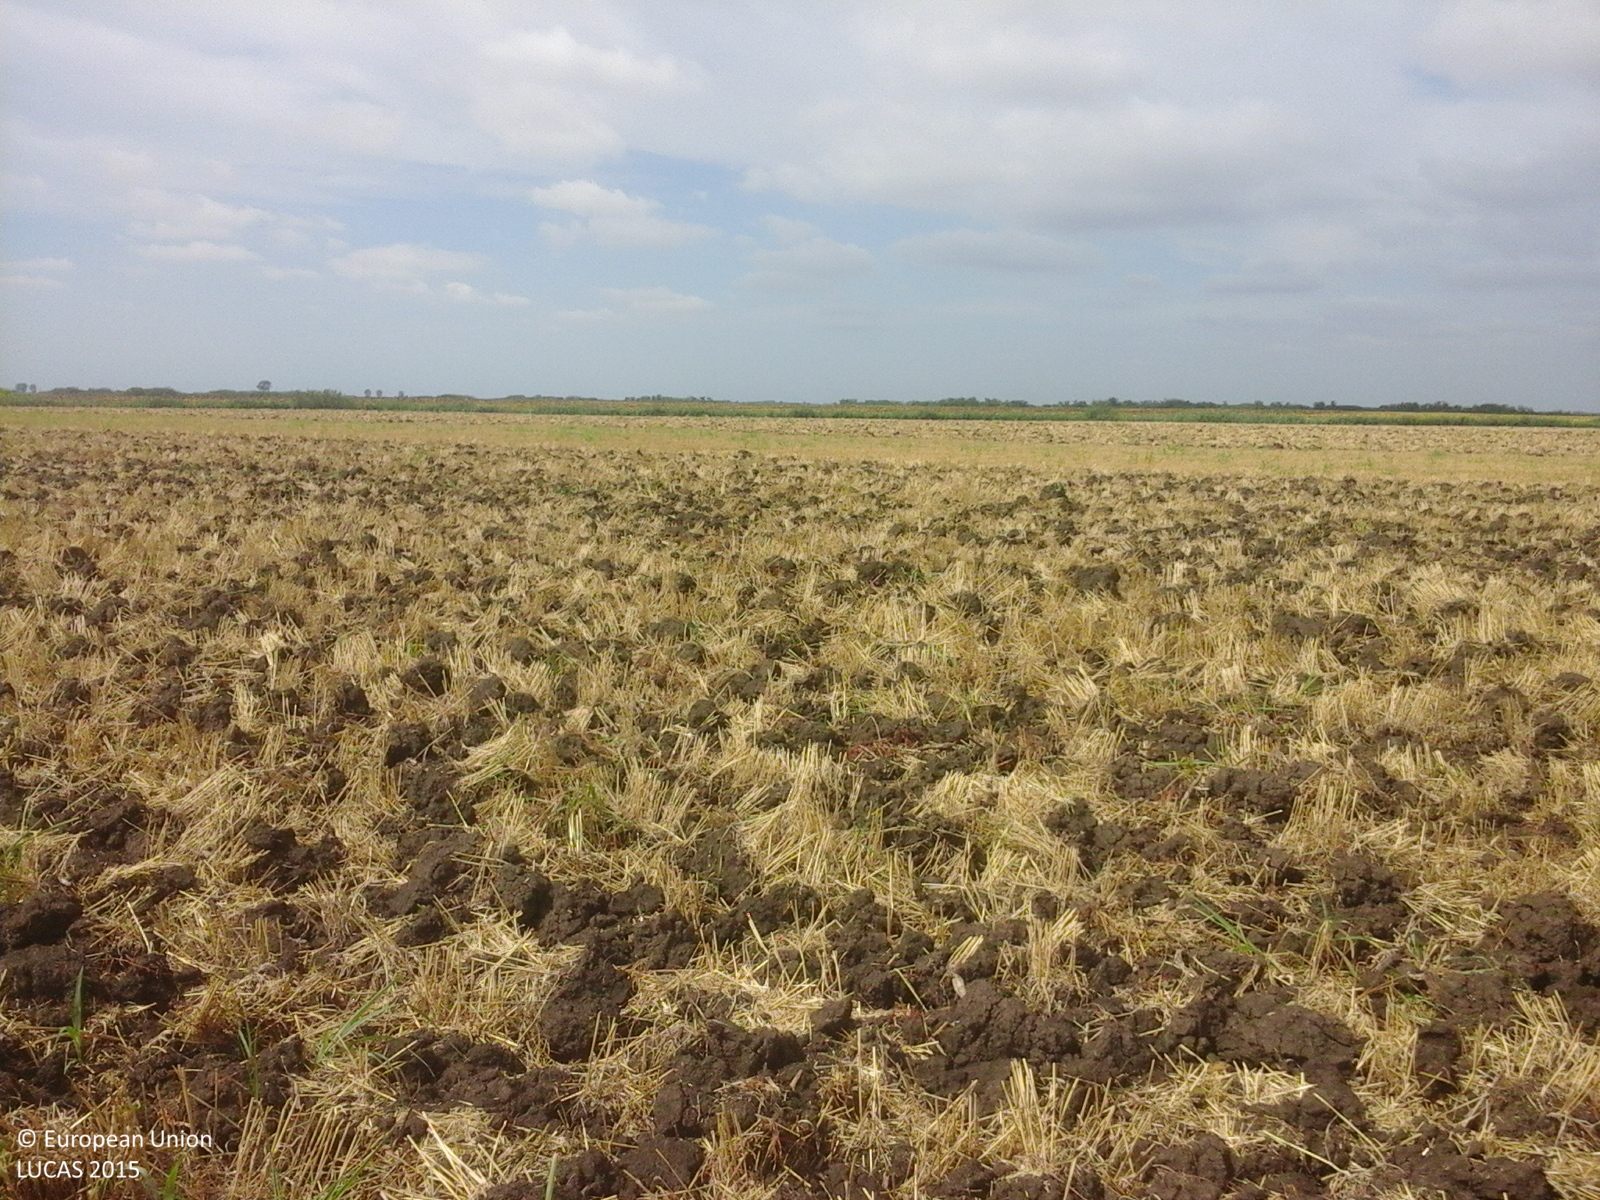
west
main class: Cropland
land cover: Common wheat
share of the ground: 10 - 25 %
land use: Agriculture (excluding fallow land and kitchen gardens)
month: August
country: RO
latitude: 45.3175
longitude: 21.2670
